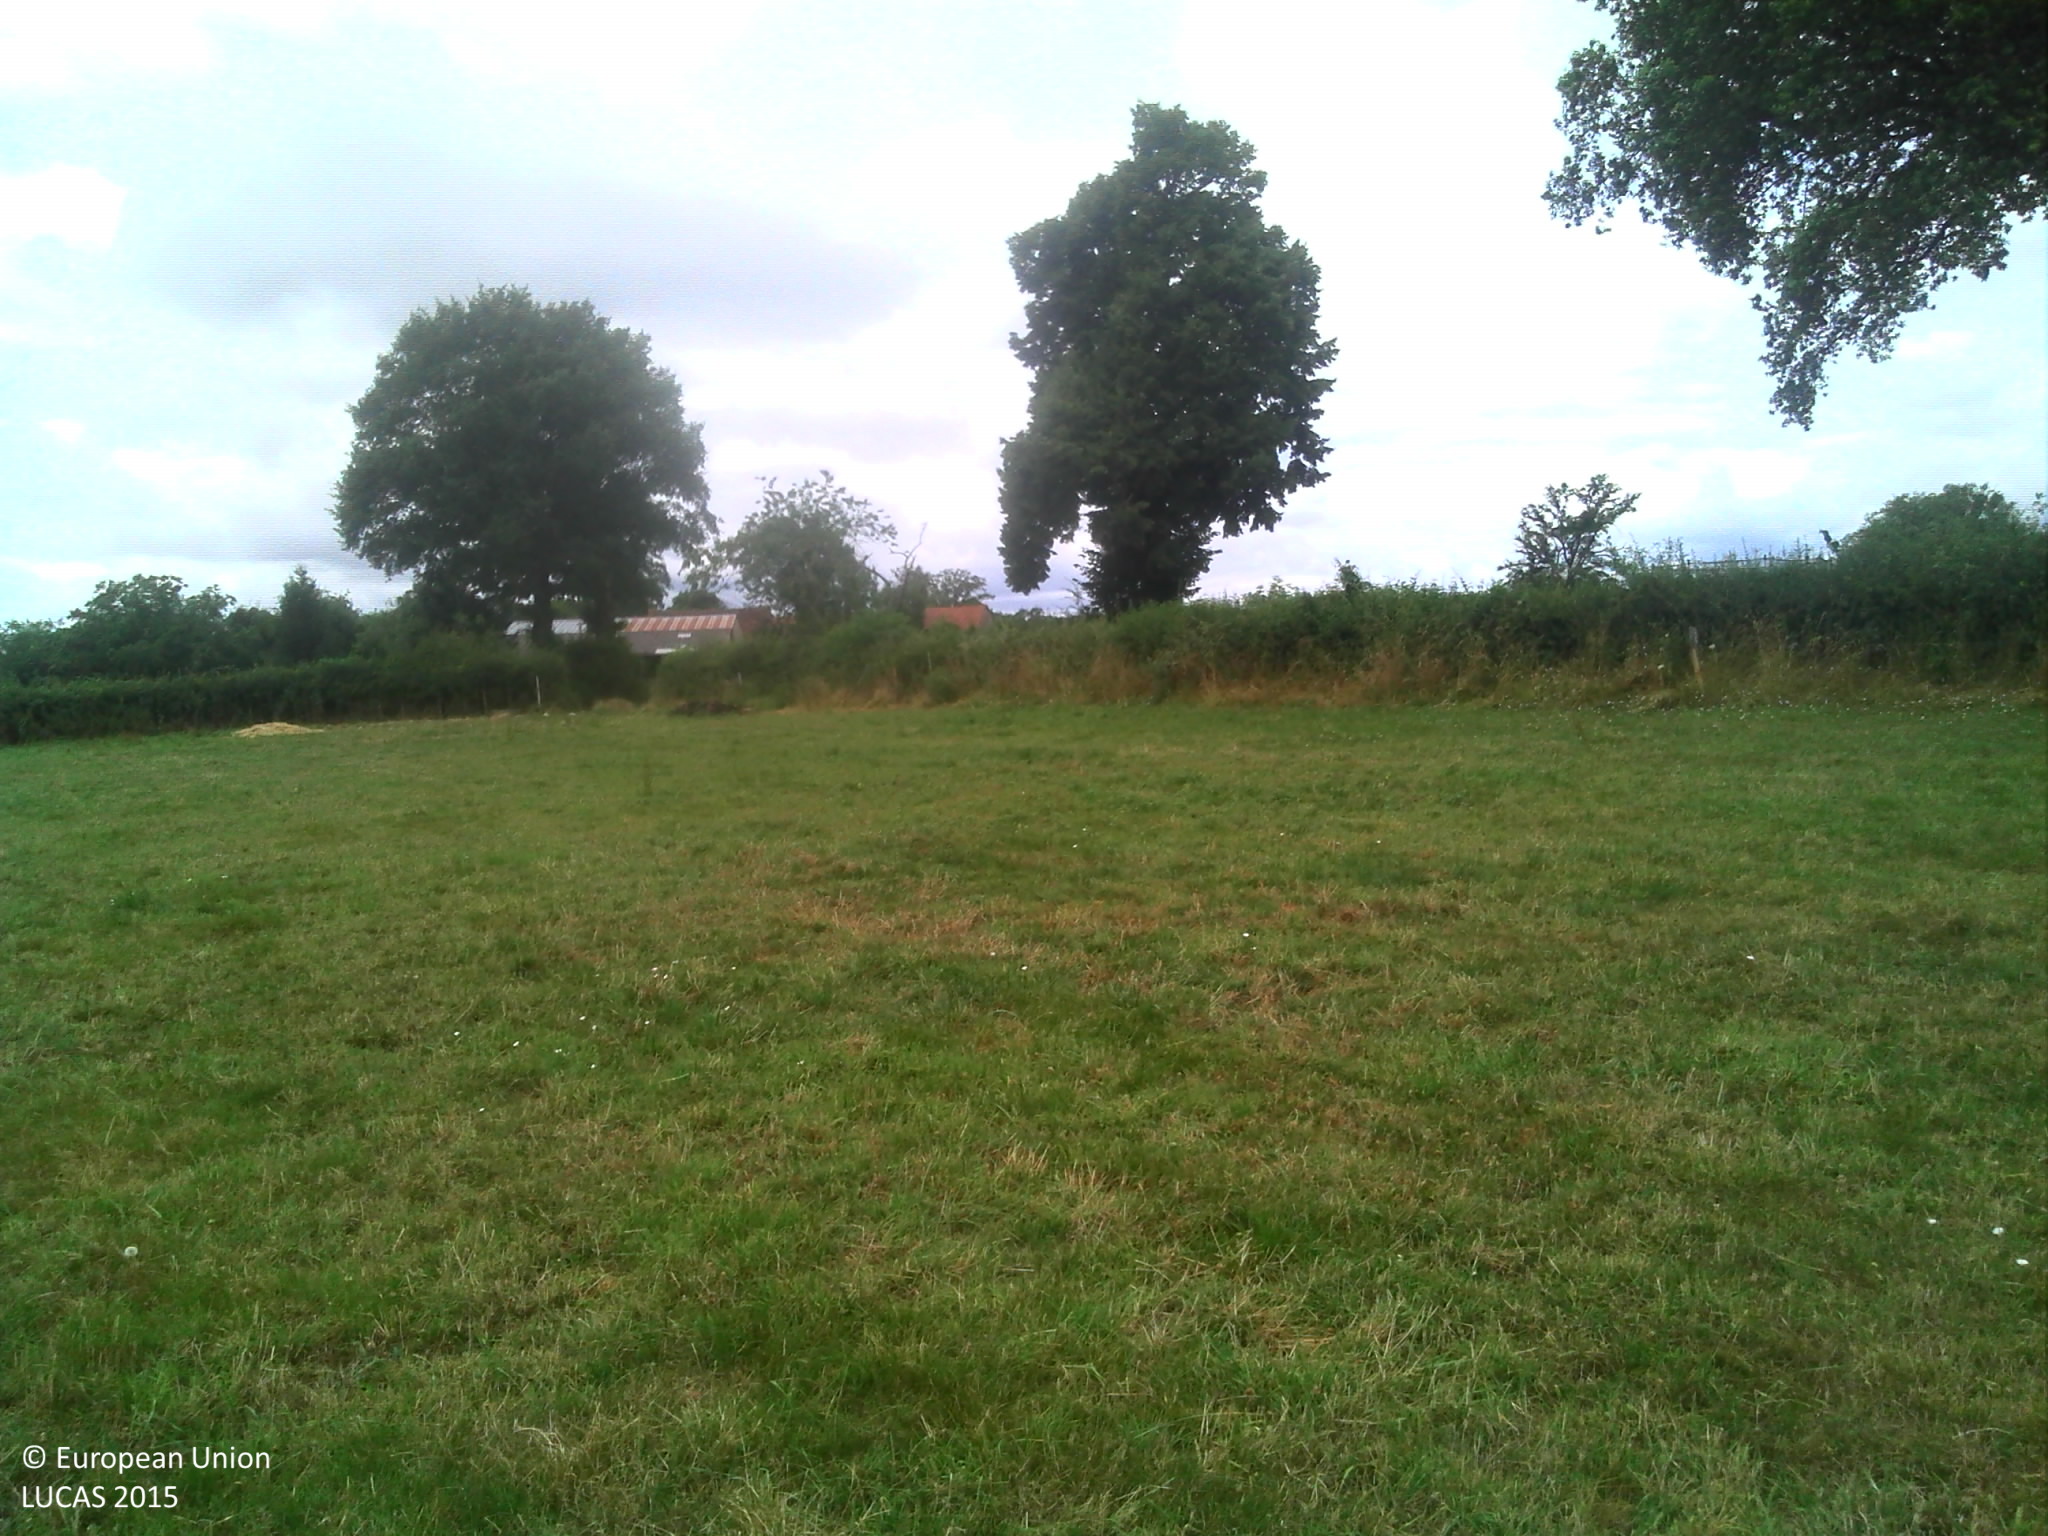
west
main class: Grassland
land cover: Grassland without tree/shrub cover
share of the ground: > 75 %
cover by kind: herbaceous plants 100 %
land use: Agriculture (excluding fallow land and kitchen gardens)
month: July
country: FR
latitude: 46.3766
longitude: 1.5267
